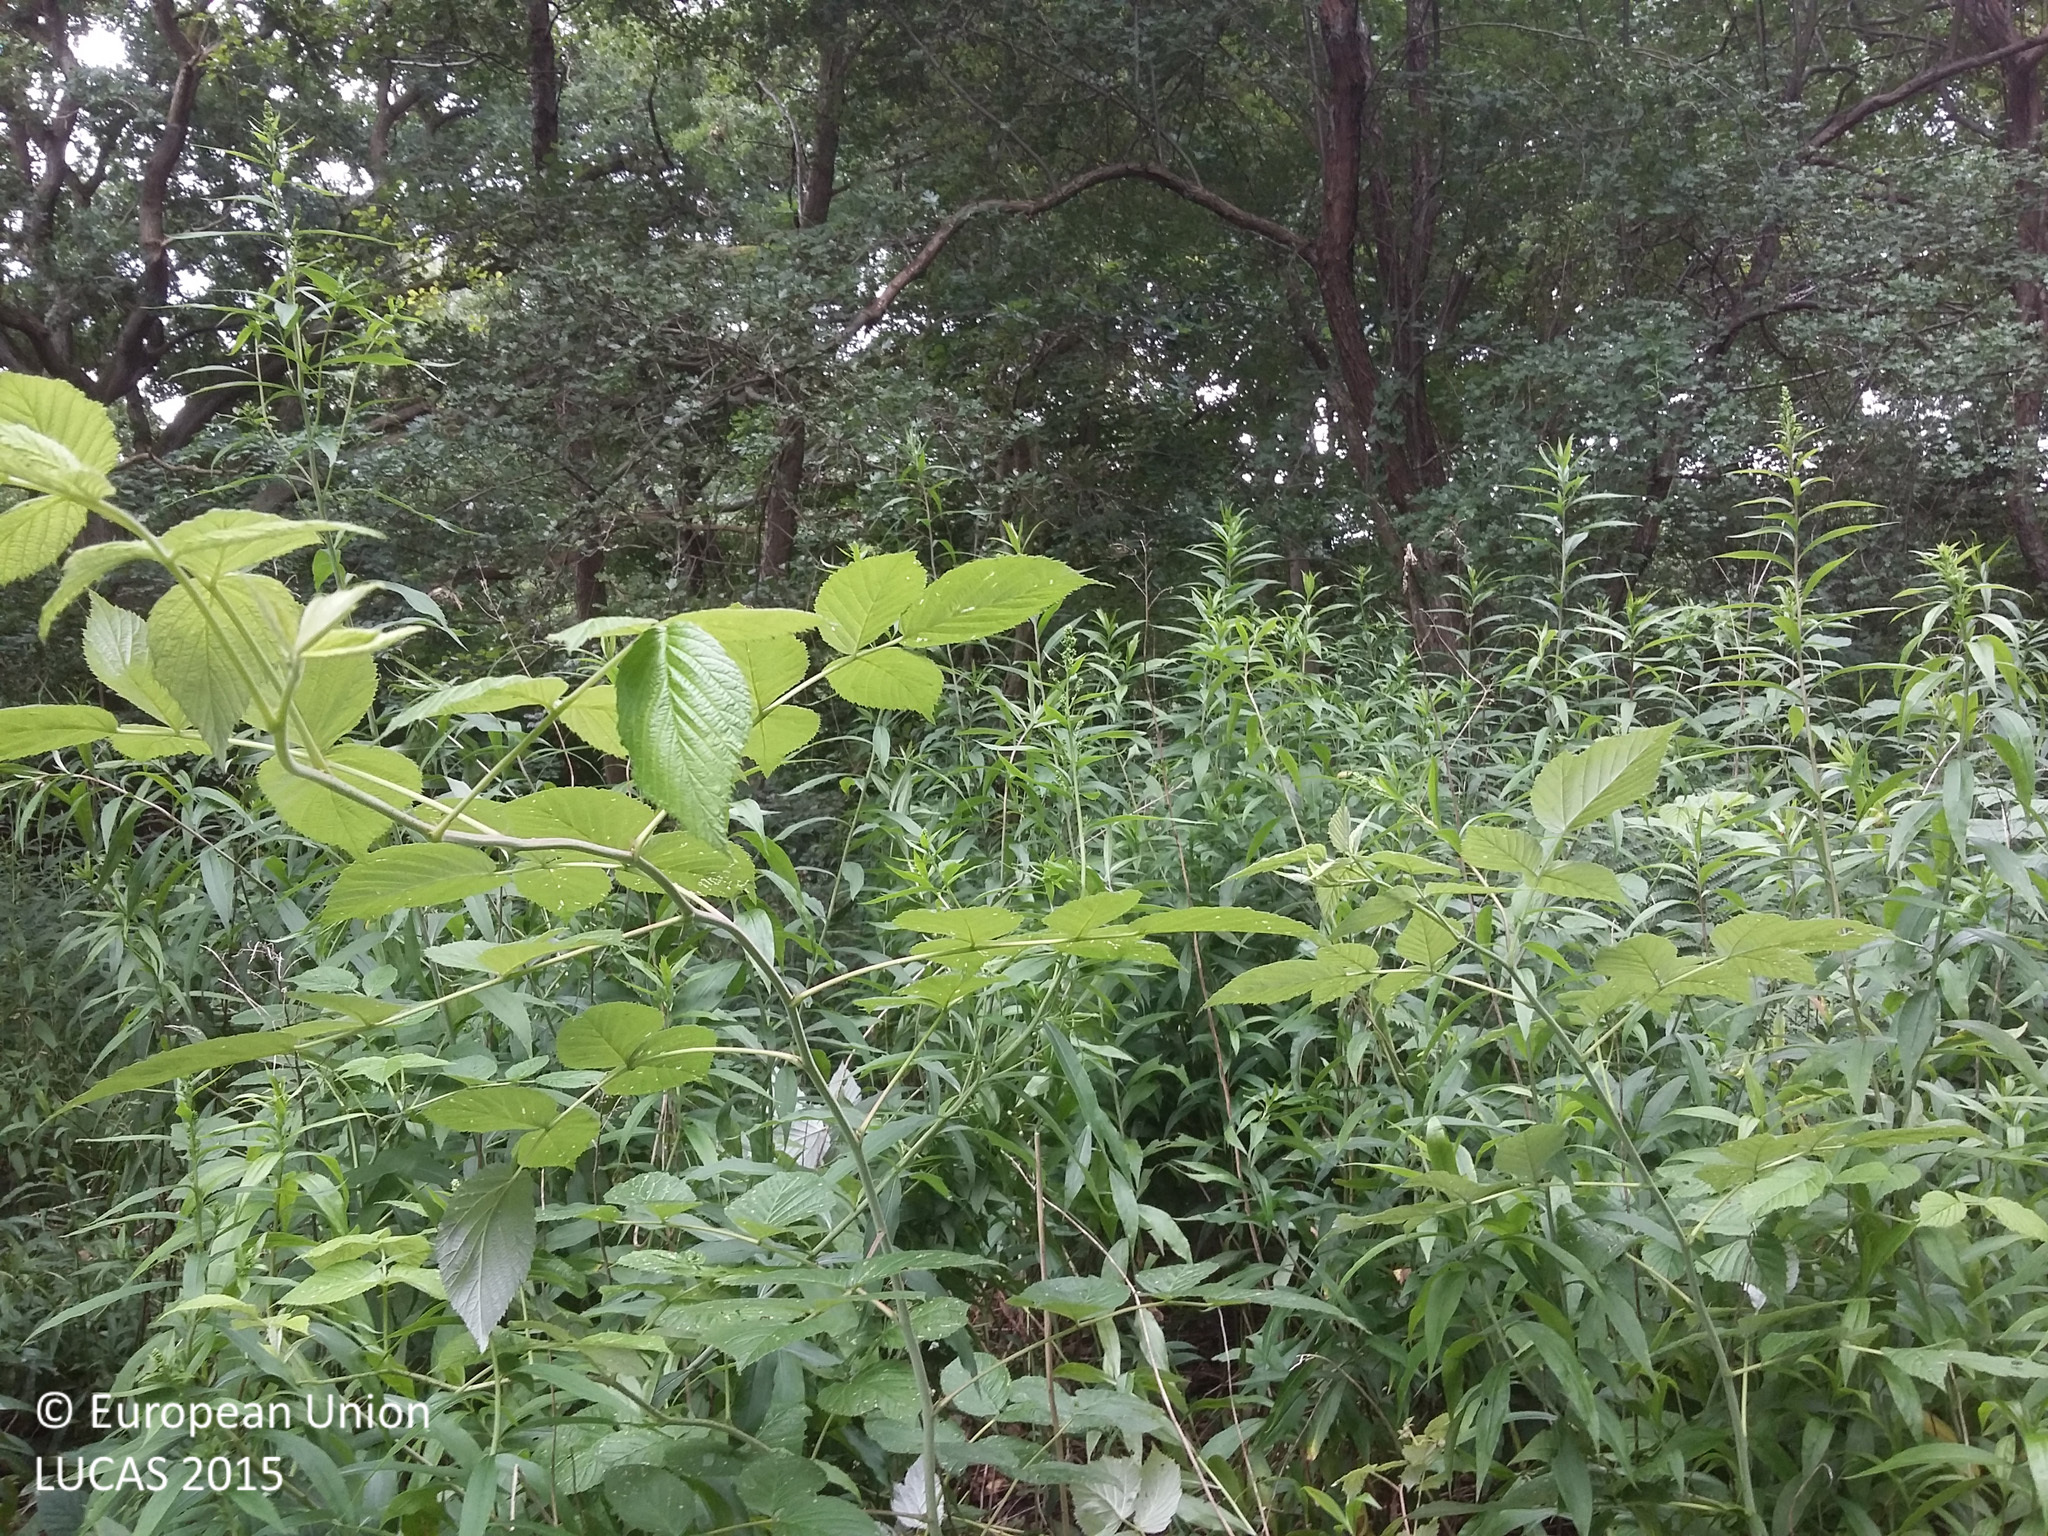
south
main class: Woodland
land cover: Broadleaved woodland
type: thermophilous deciduous forest
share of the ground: 50 - 75 %
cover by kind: herbaceous plants 50 %, broadleaved forest trees 45 %, coniferous forest trees 5 %
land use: Semi-natural and natural areas not in use
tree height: > 5 m
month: July
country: DK
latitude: 55.8031
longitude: 12.5345
